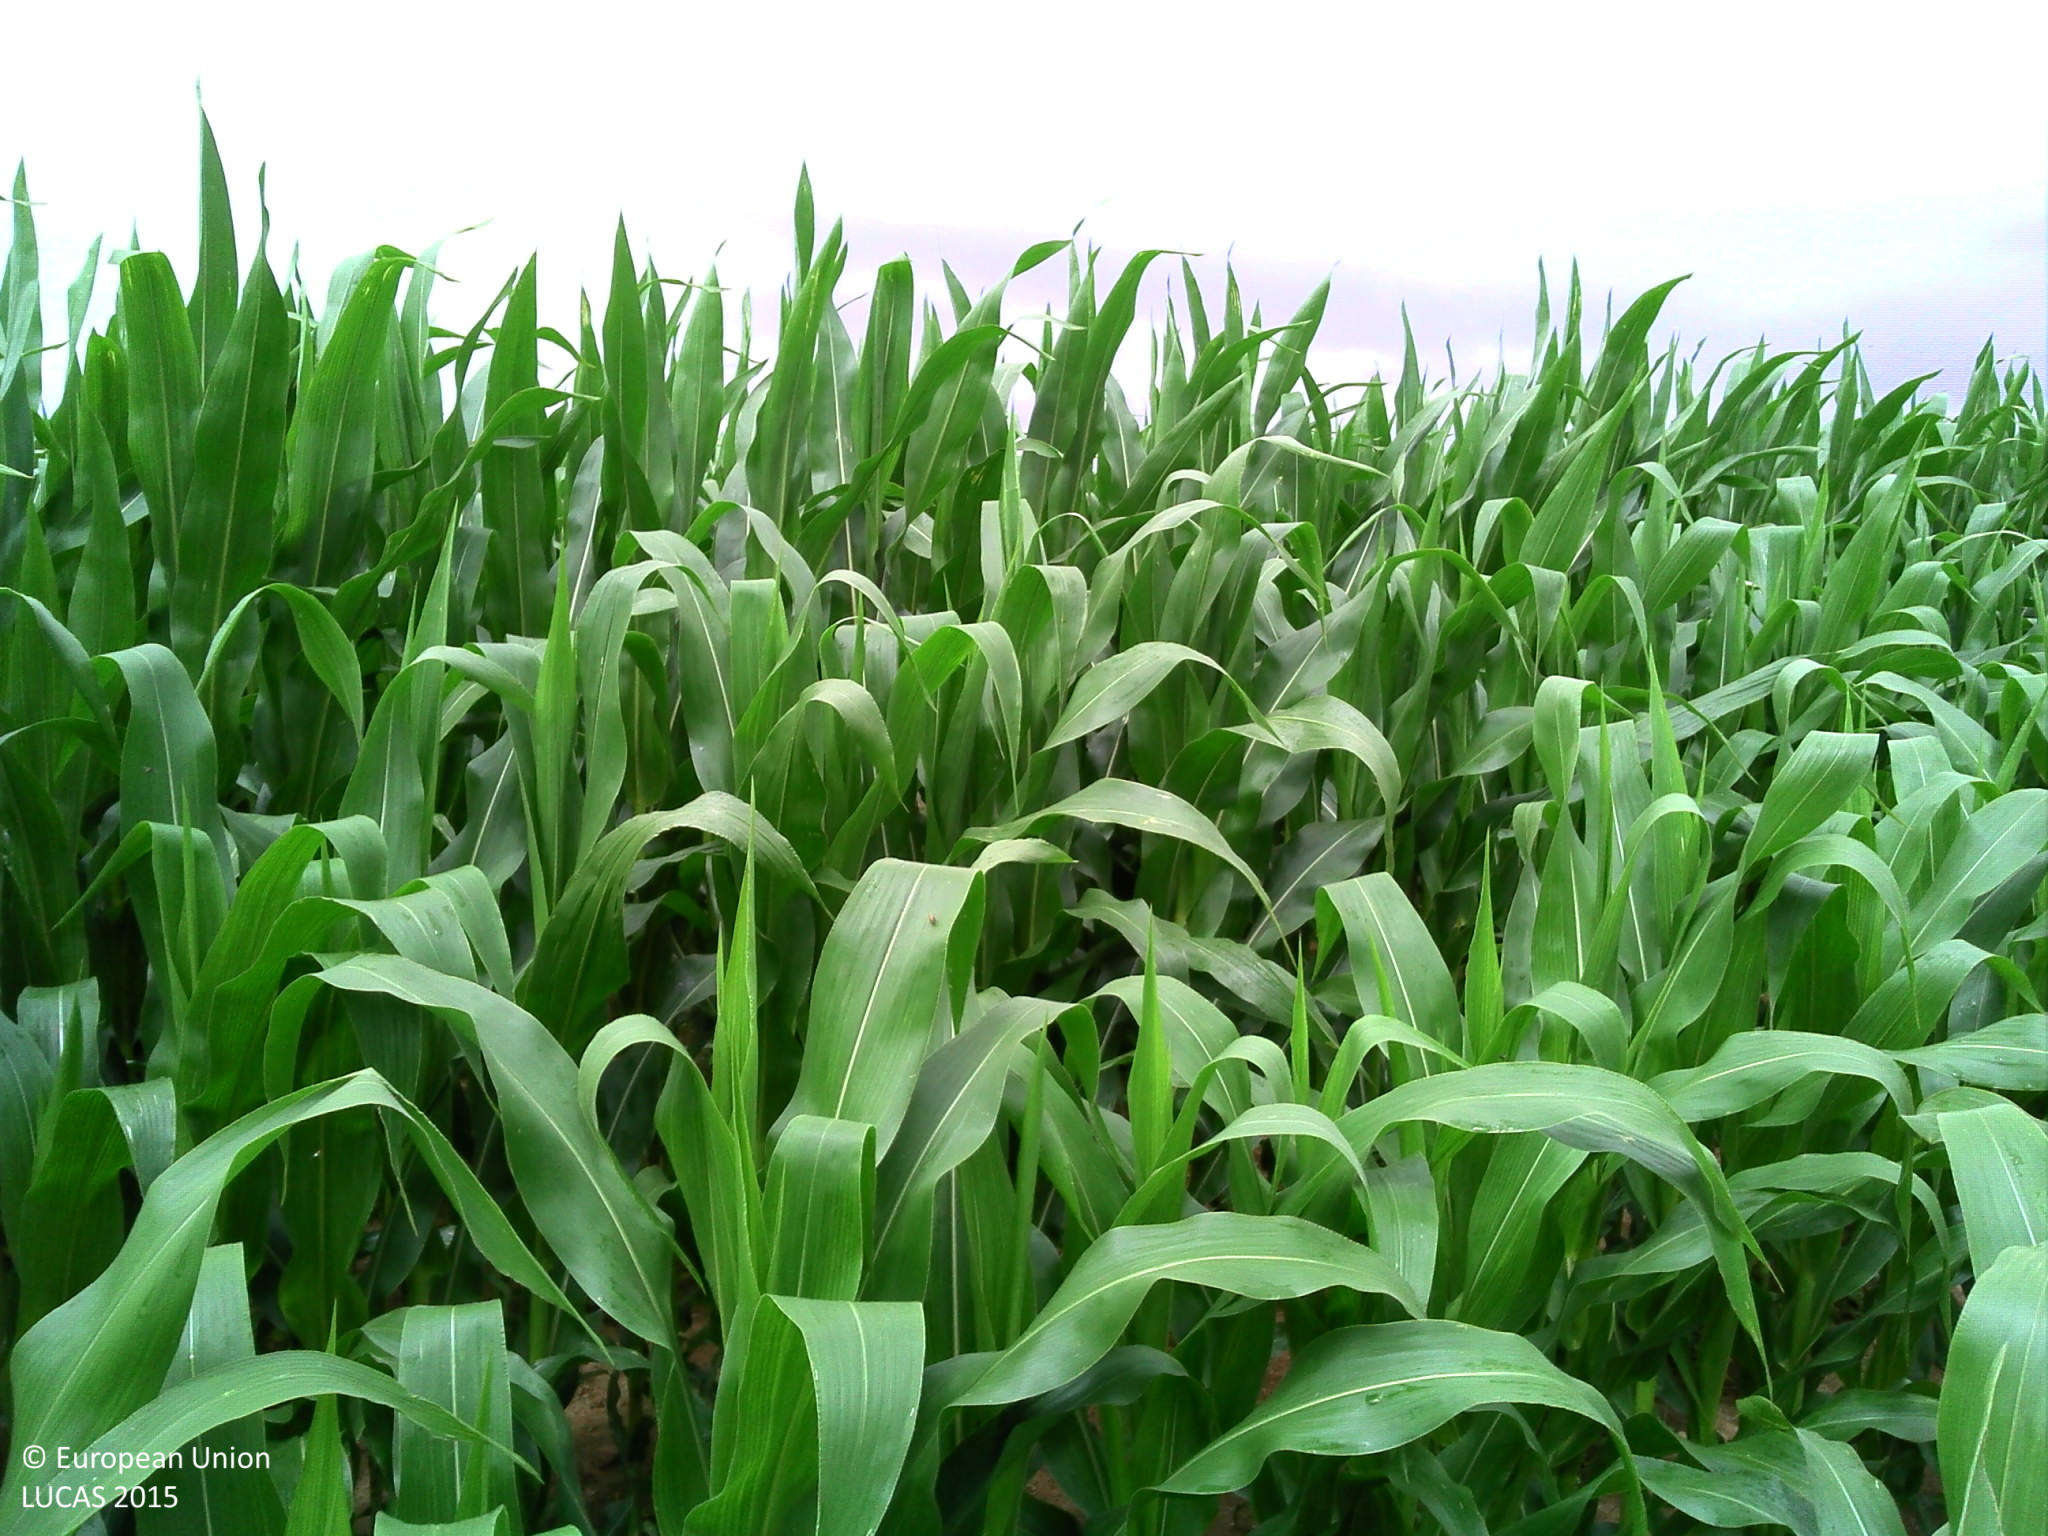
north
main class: Cropland
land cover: Maize
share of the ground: > 75 %
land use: Agriculture (excluding fallow land and kitchen gardens)
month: July
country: FR
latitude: 50.1198
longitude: 2.5332
